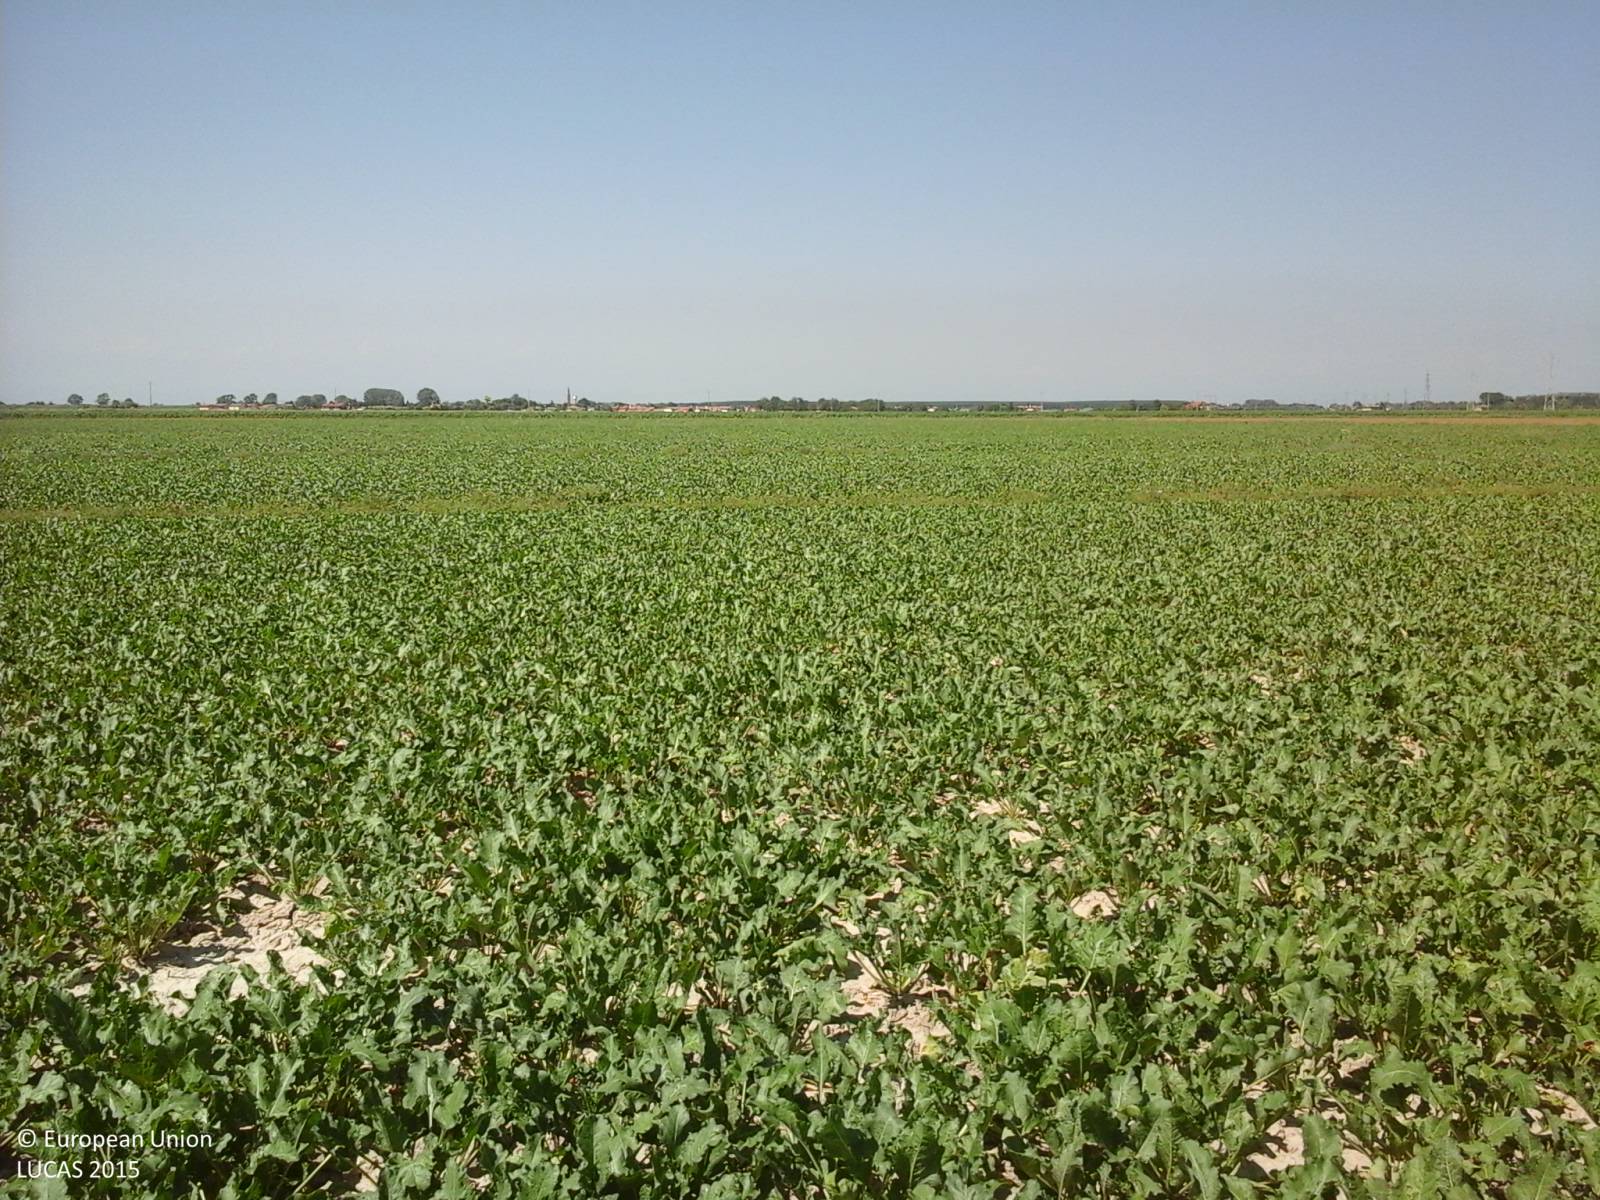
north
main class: Cropland
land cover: Sugar beet
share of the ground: > 75 %
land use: Agriculture (excluding fallow land and kitchen gardens)
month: July
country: IT
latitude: 45.6958
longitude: 13.0139
